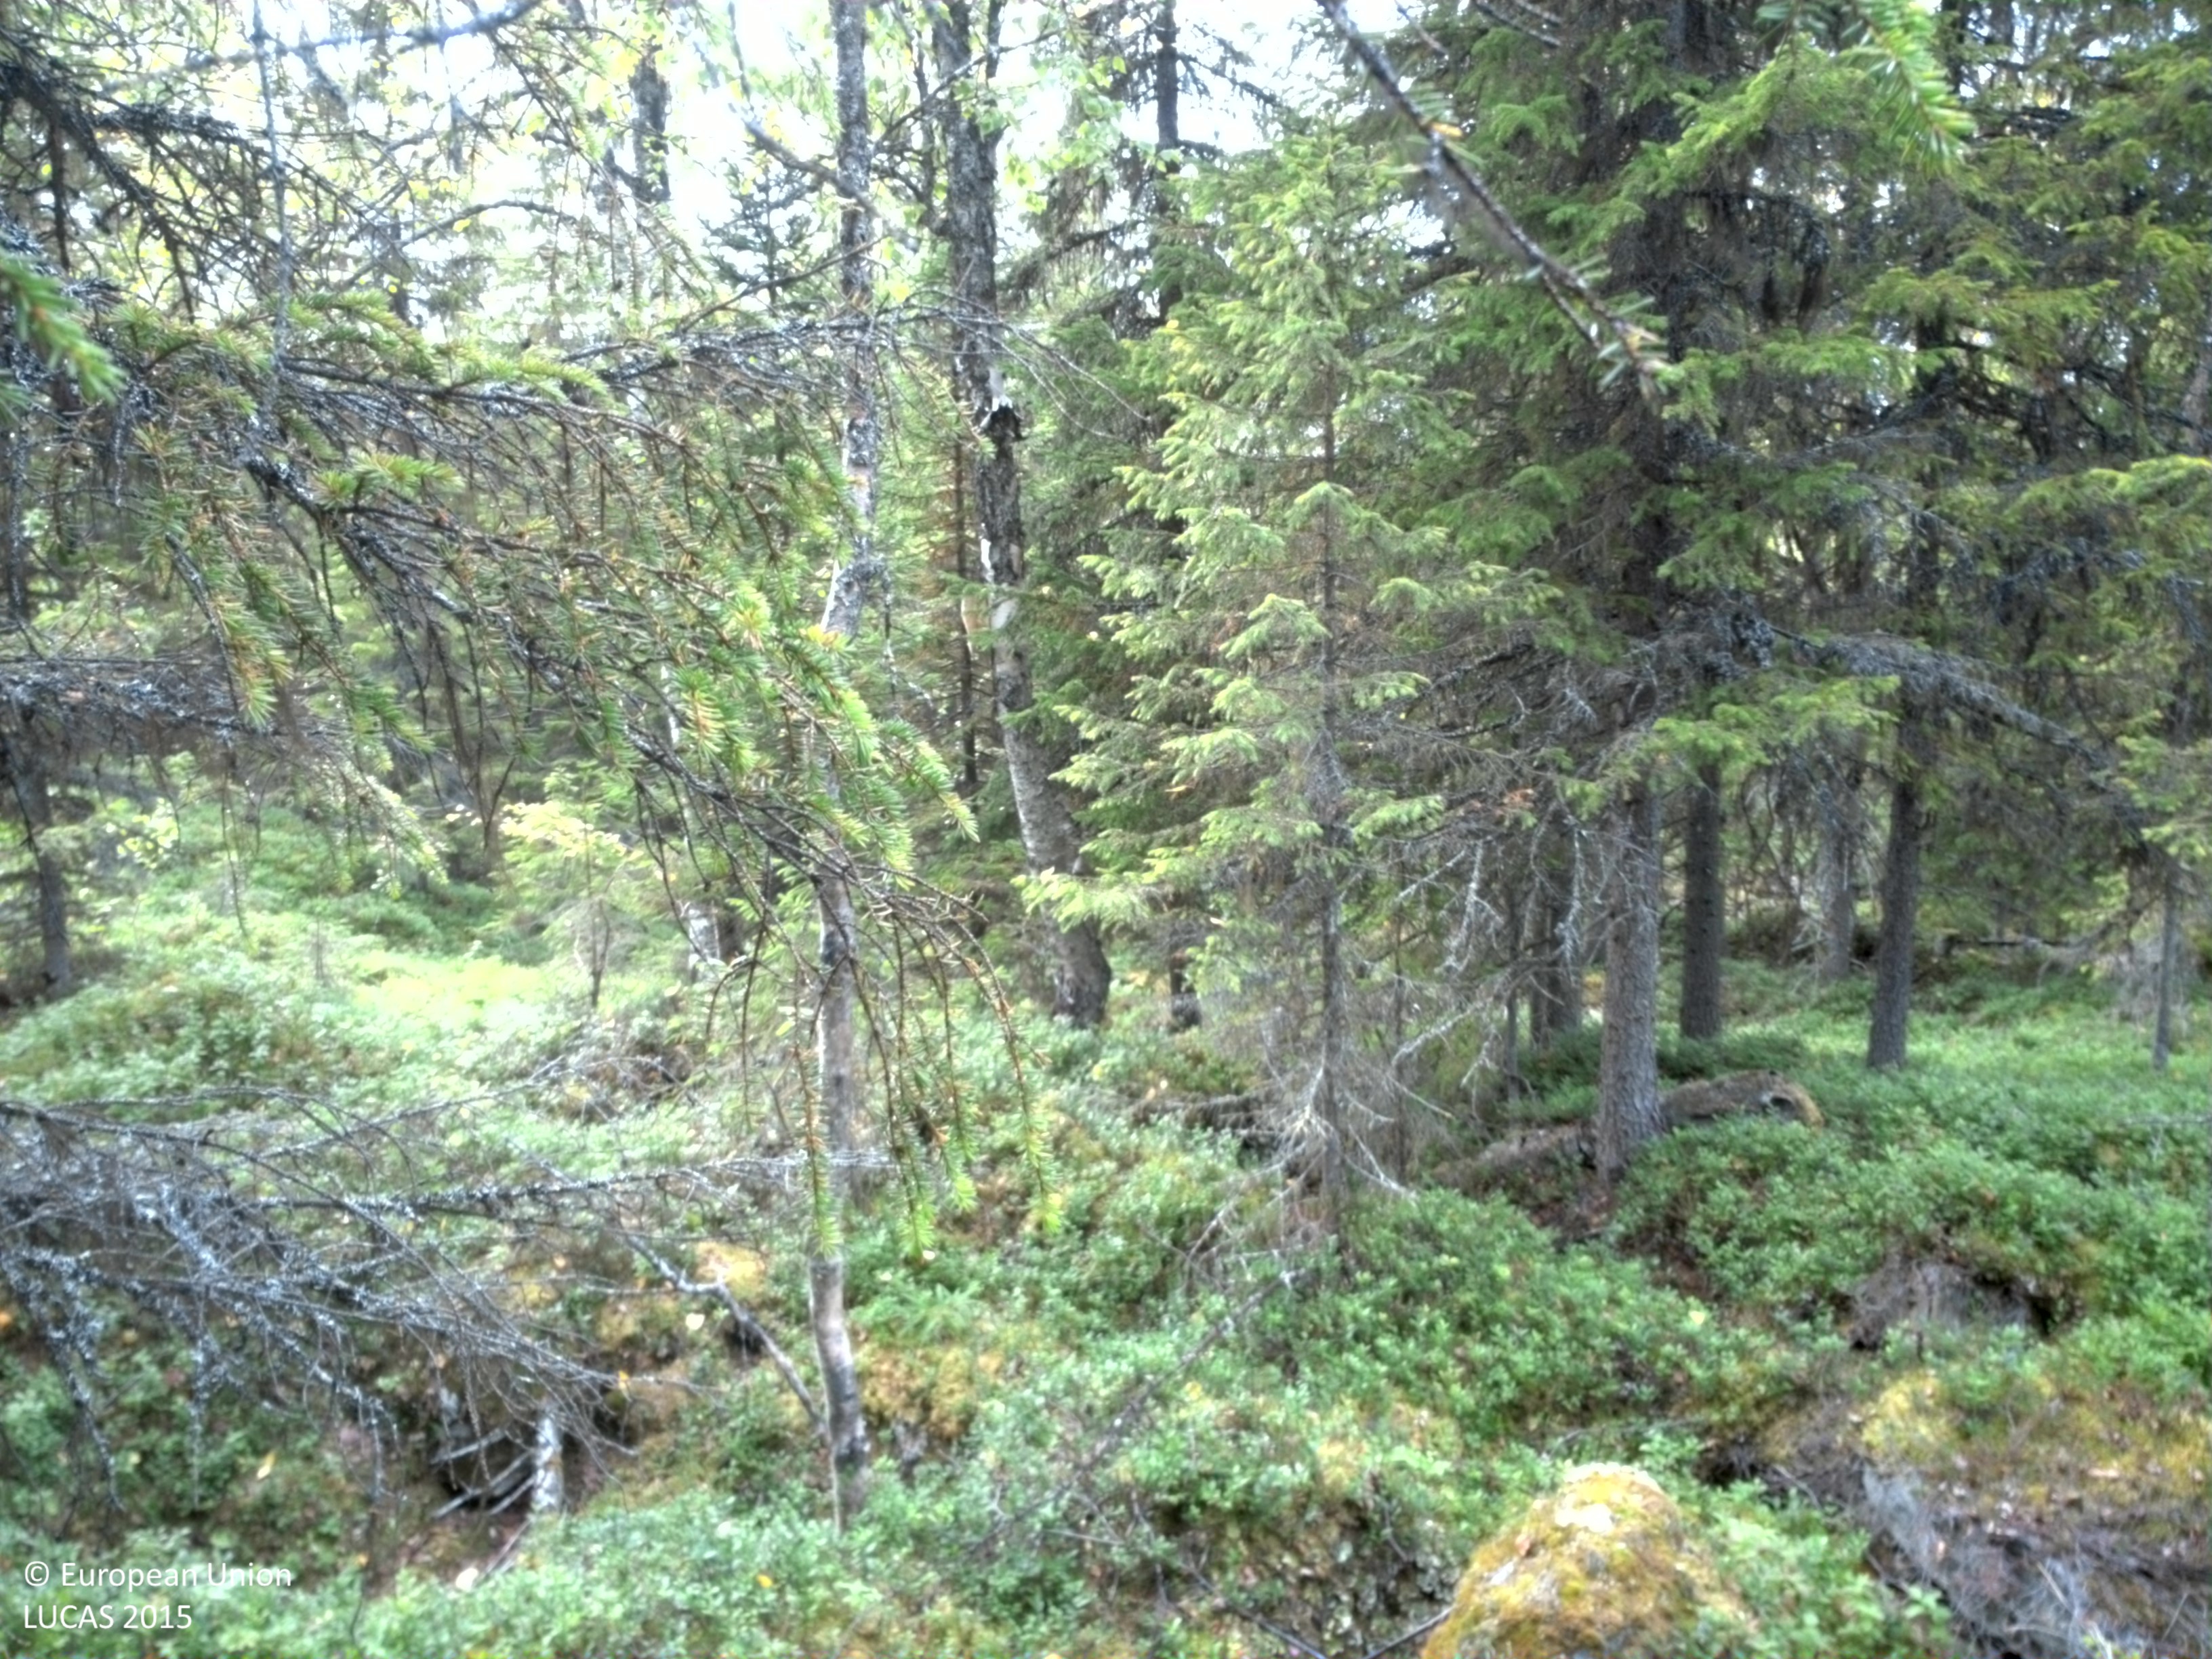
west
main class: Woodland
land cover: Spruce dominated mixed woodland
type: boreal forest
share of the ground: 25 - 50 %
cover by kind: coniferous forest trees 30 %, shrubs 30 %, broadleaved forest trees 20 %, lichens and mosses 15 %, herbaceous plants 5 %
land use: Forestry
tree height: > 5 m
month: September
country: SE
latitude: 65.3475
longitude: 16.1728
